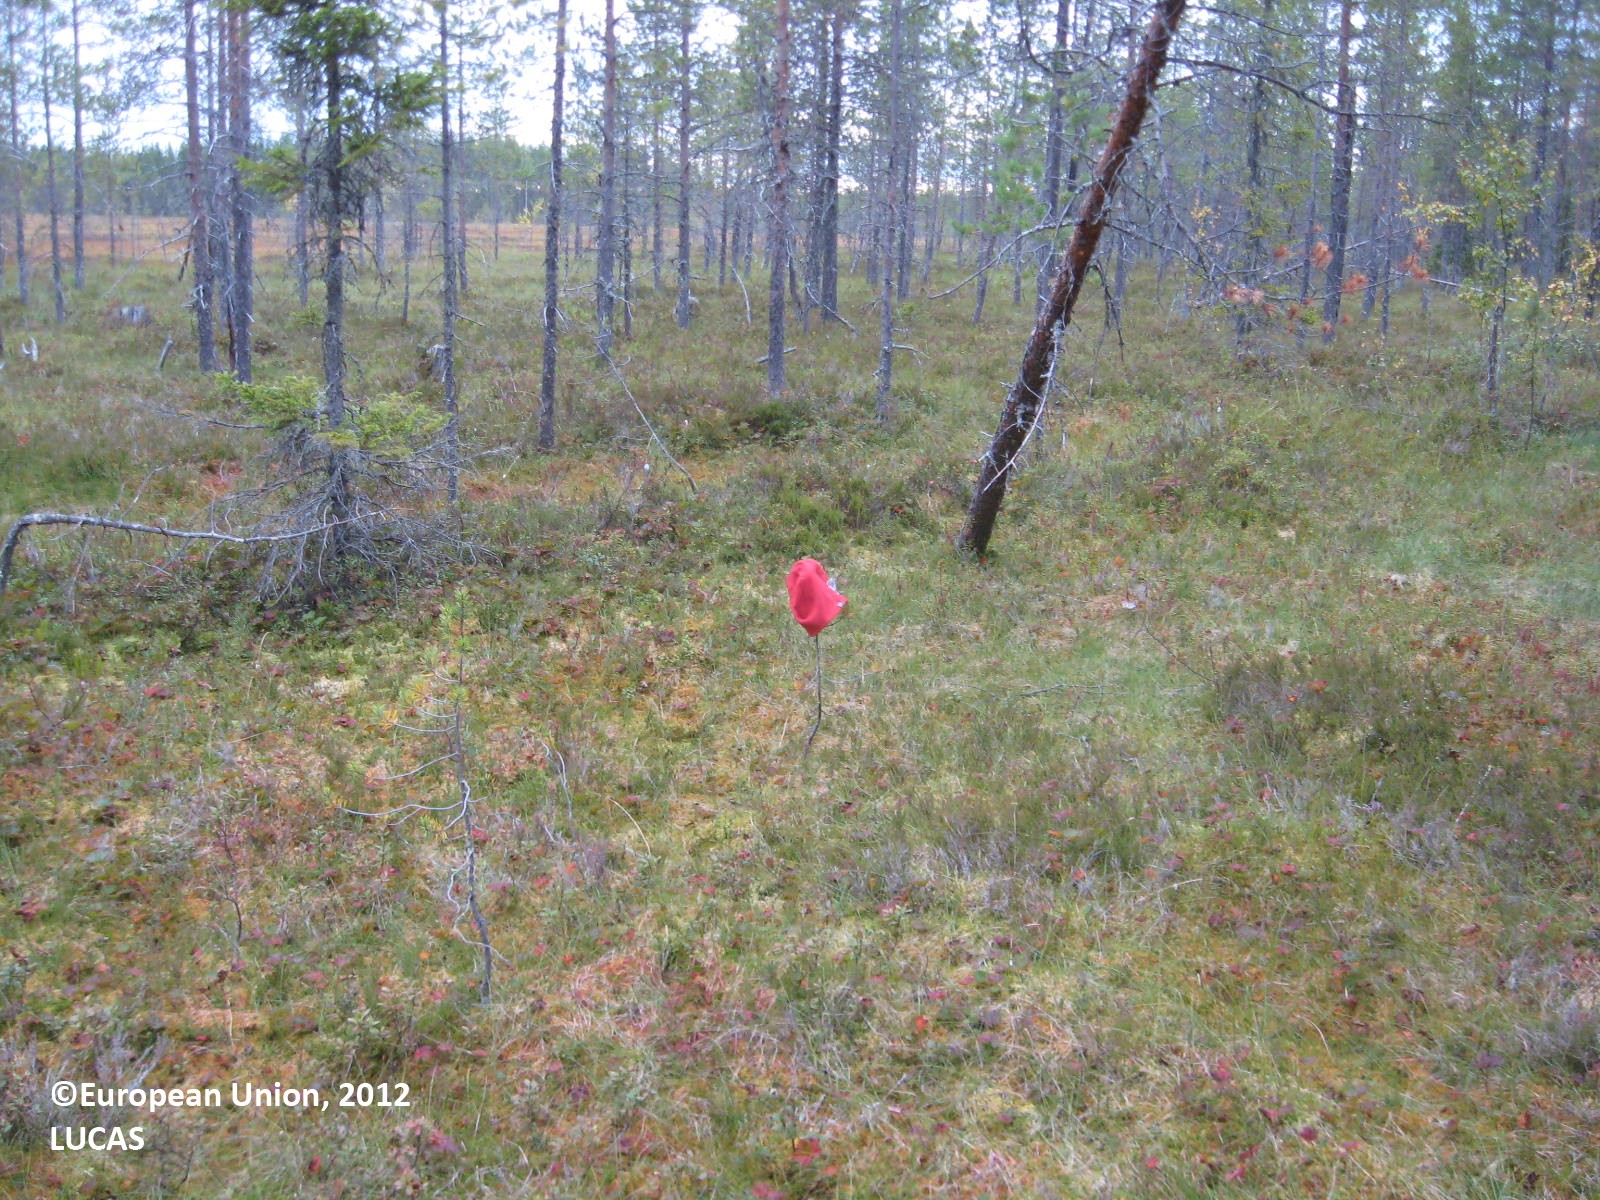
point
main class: Woodland
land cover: Pine dominated coniferous woodland
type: boreal forest
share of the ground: 50 - 75 %
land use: Semi-natural and natural areas not in use
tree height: > 5 m
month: August
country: FI
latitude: 63.7242
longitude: 29.6888
